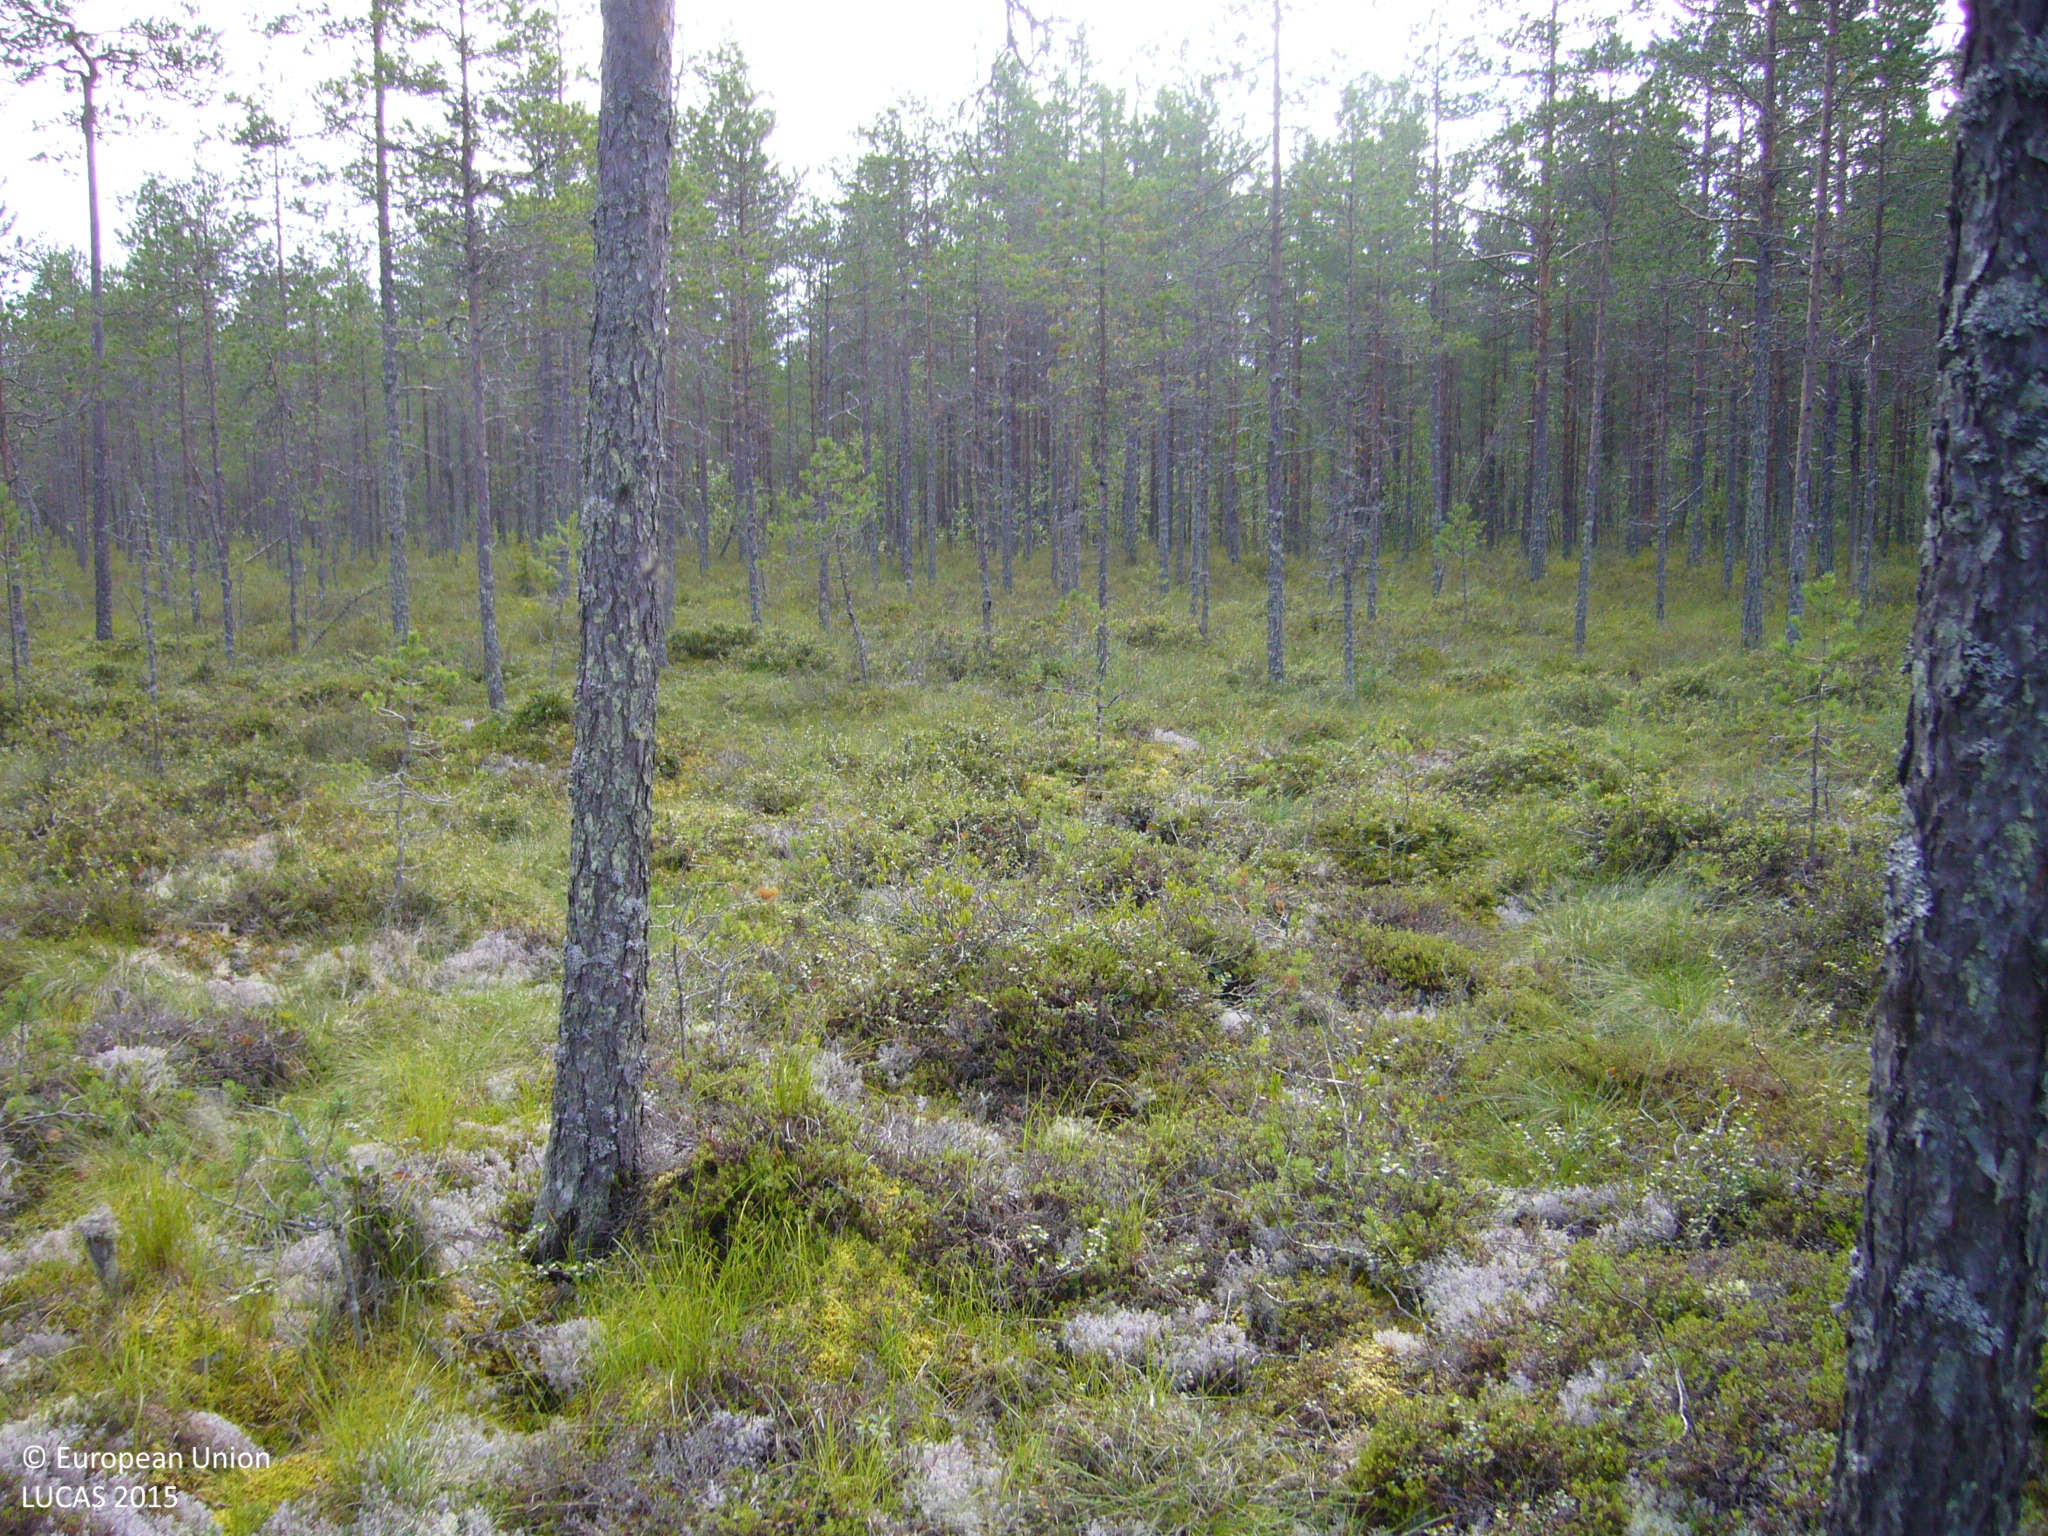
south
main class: Woodland
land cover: Pine dominated coniferous woodland
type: boreal forest
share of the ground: 50 - 75 %
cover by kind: coniferous forest trees 50 %, lichens and mosses 30 %, shrubs 20 %
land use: Forestry
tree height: > 5 m
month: July
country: FI
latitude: 64.1011
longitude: 26.1361
